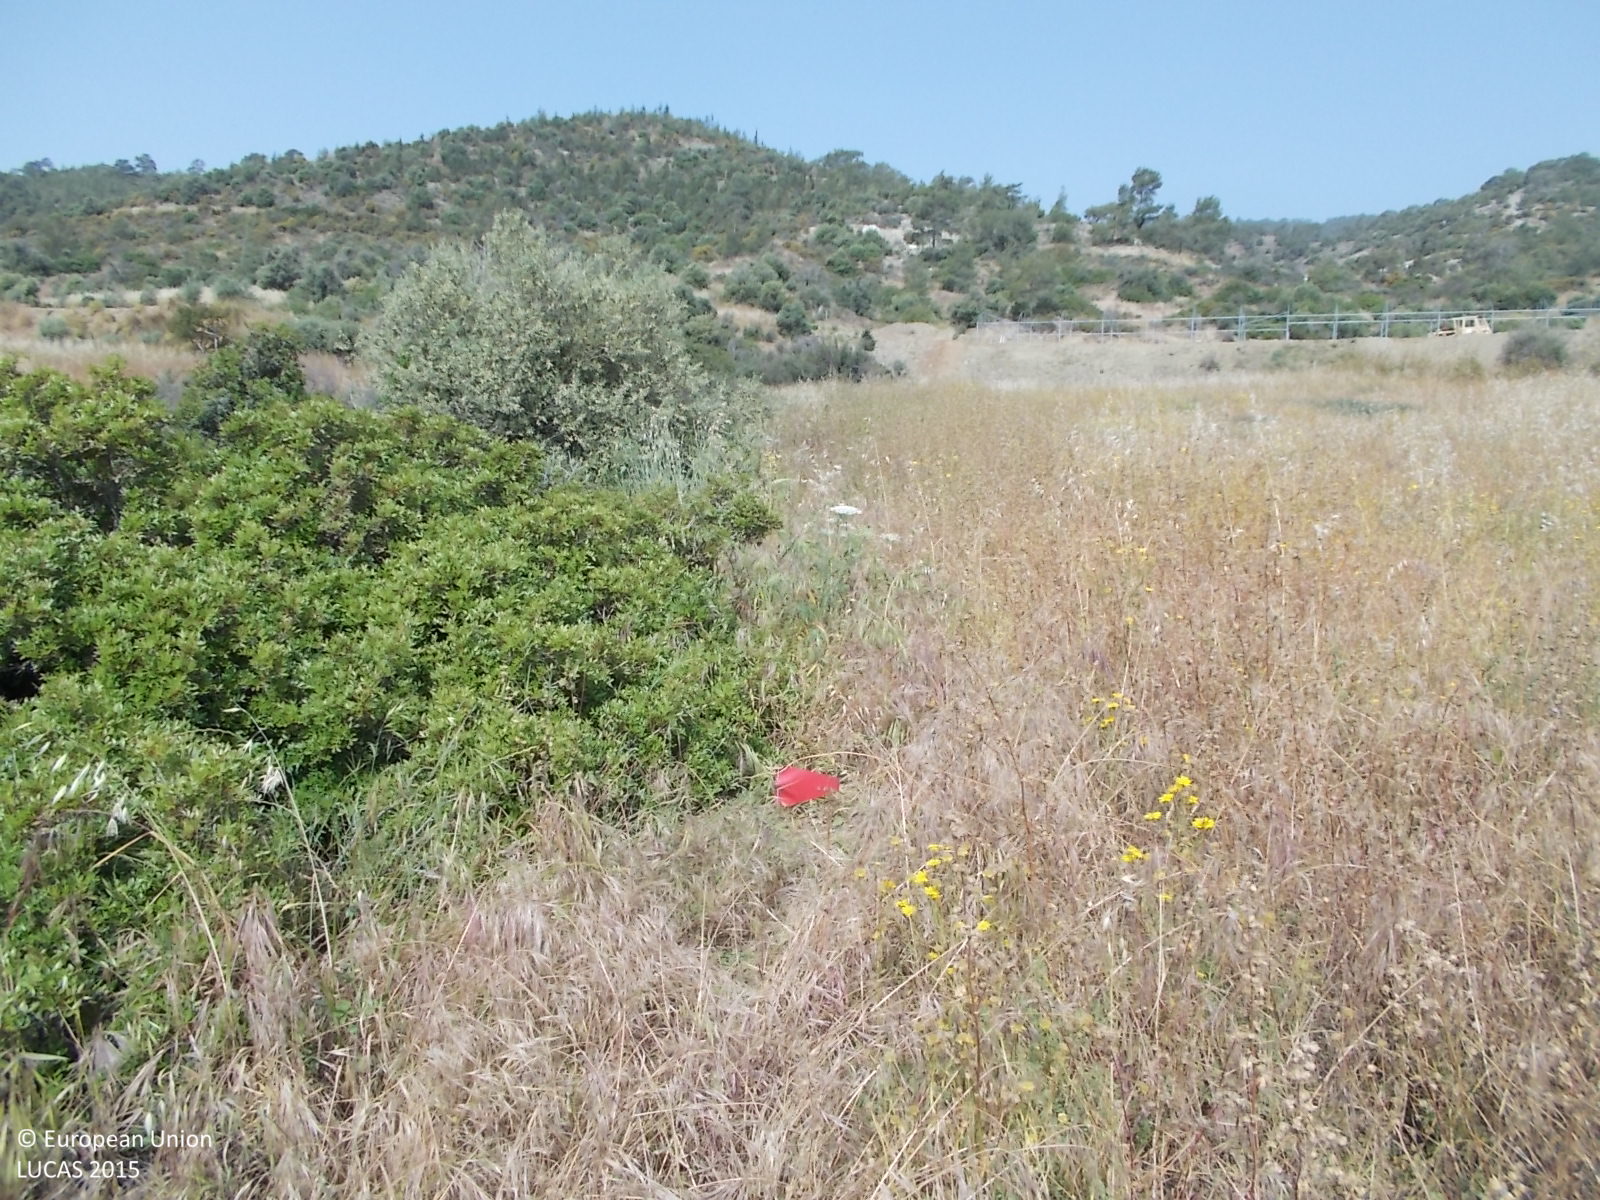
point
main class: Grassland
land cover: Spontaneously vegetated surfaces
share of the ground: > 75 %
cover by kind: herbaceous plants 100 %
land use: Fallow land
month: April
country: CY
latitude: 34.7739
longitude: 33.1512
